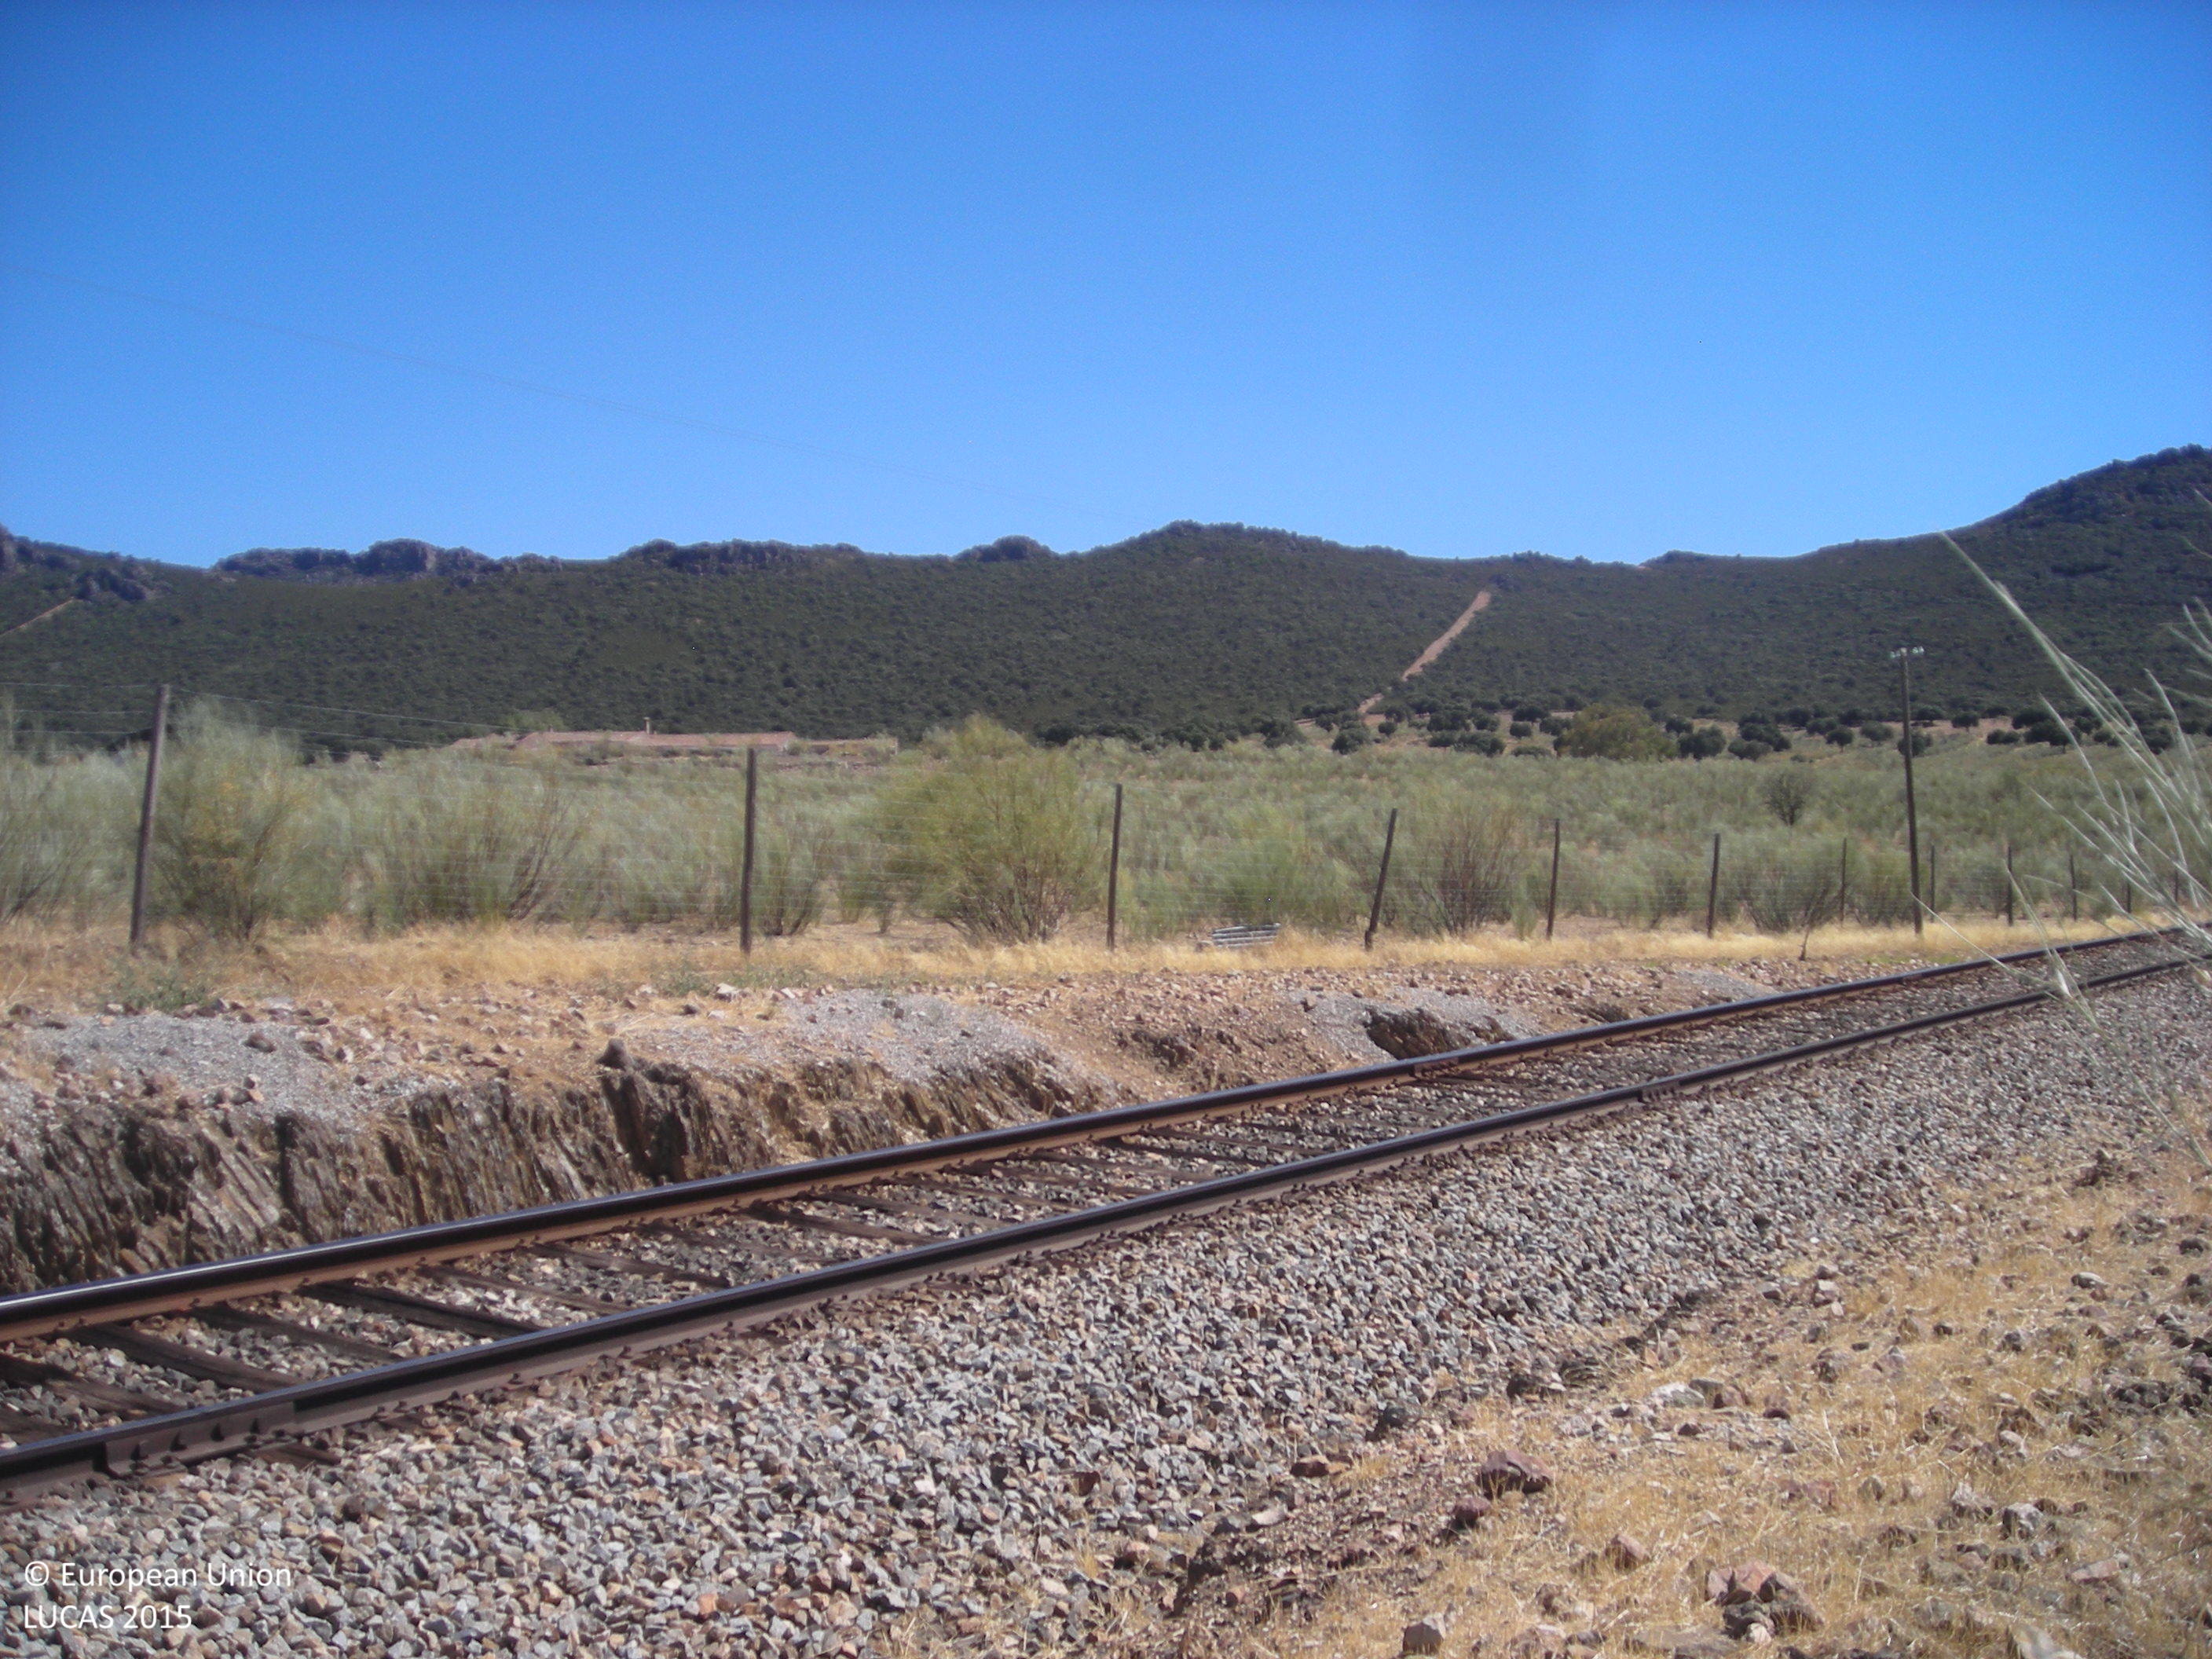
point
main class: Shrubland
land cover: Shrubland without tree cover
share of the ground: > 75 %
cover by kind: shrubs 50 %, herbaceous plants 50 %
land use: Agriculture (excluding fallow land and kitchen gardens)
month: July
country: ES
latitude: 38.6961
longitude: -5.3862
